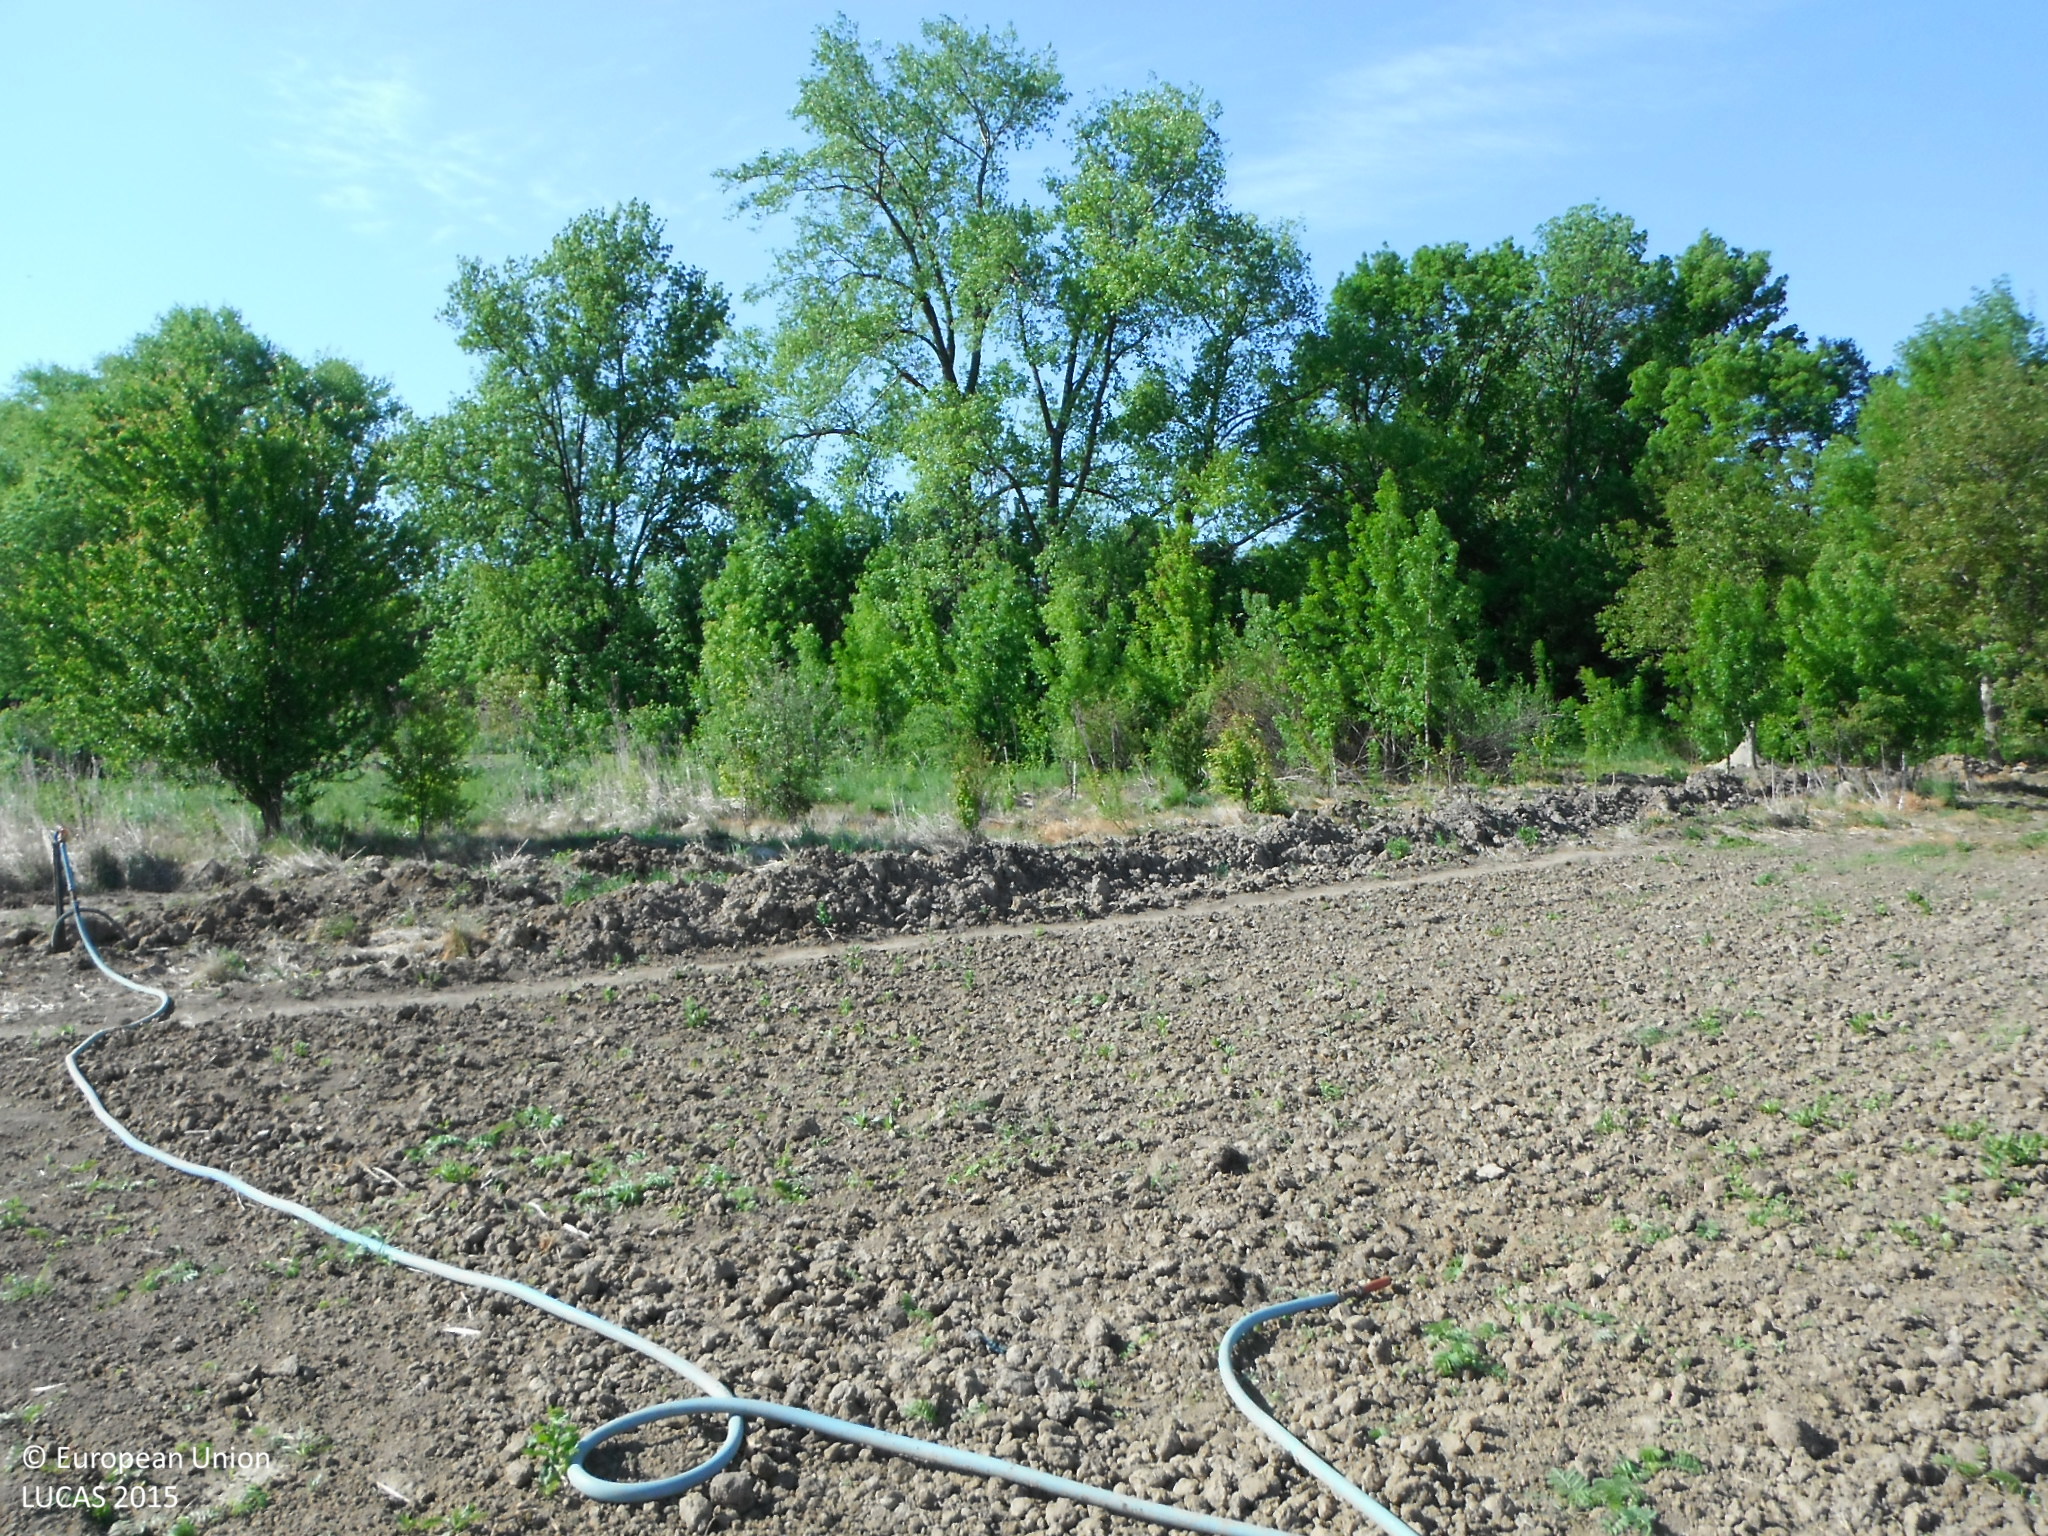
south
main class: Cropland
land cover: Other root crops
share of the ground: 10 - 25 %
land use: Kitchen garden
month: May
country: SK
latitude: 48.3453
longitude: 18.2860
